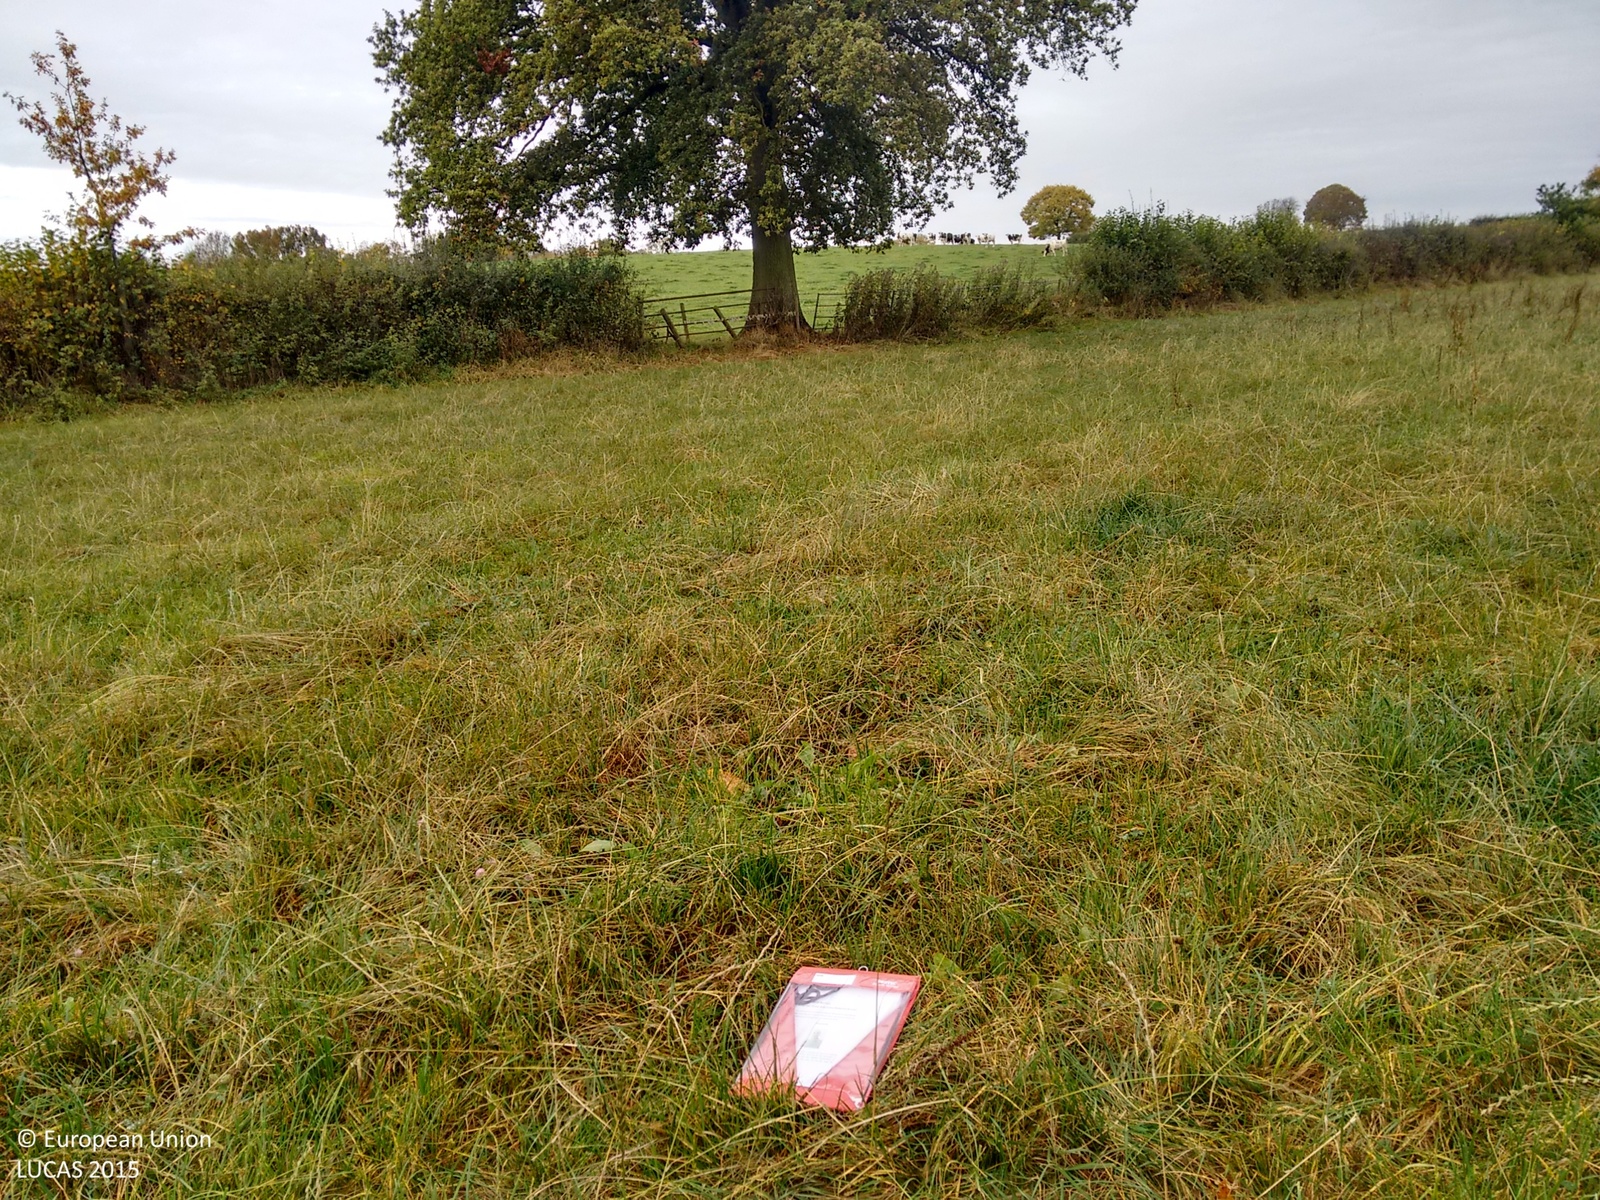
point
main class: Grassland
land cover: Grassland without tree/shrub cover
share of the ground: > 75 %
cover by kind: herbaceous plants 100 %
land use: Agriculture (excluding fallow land and kitchen gardens)
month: October
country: GB
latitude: 52.3505
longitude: -2.5011
